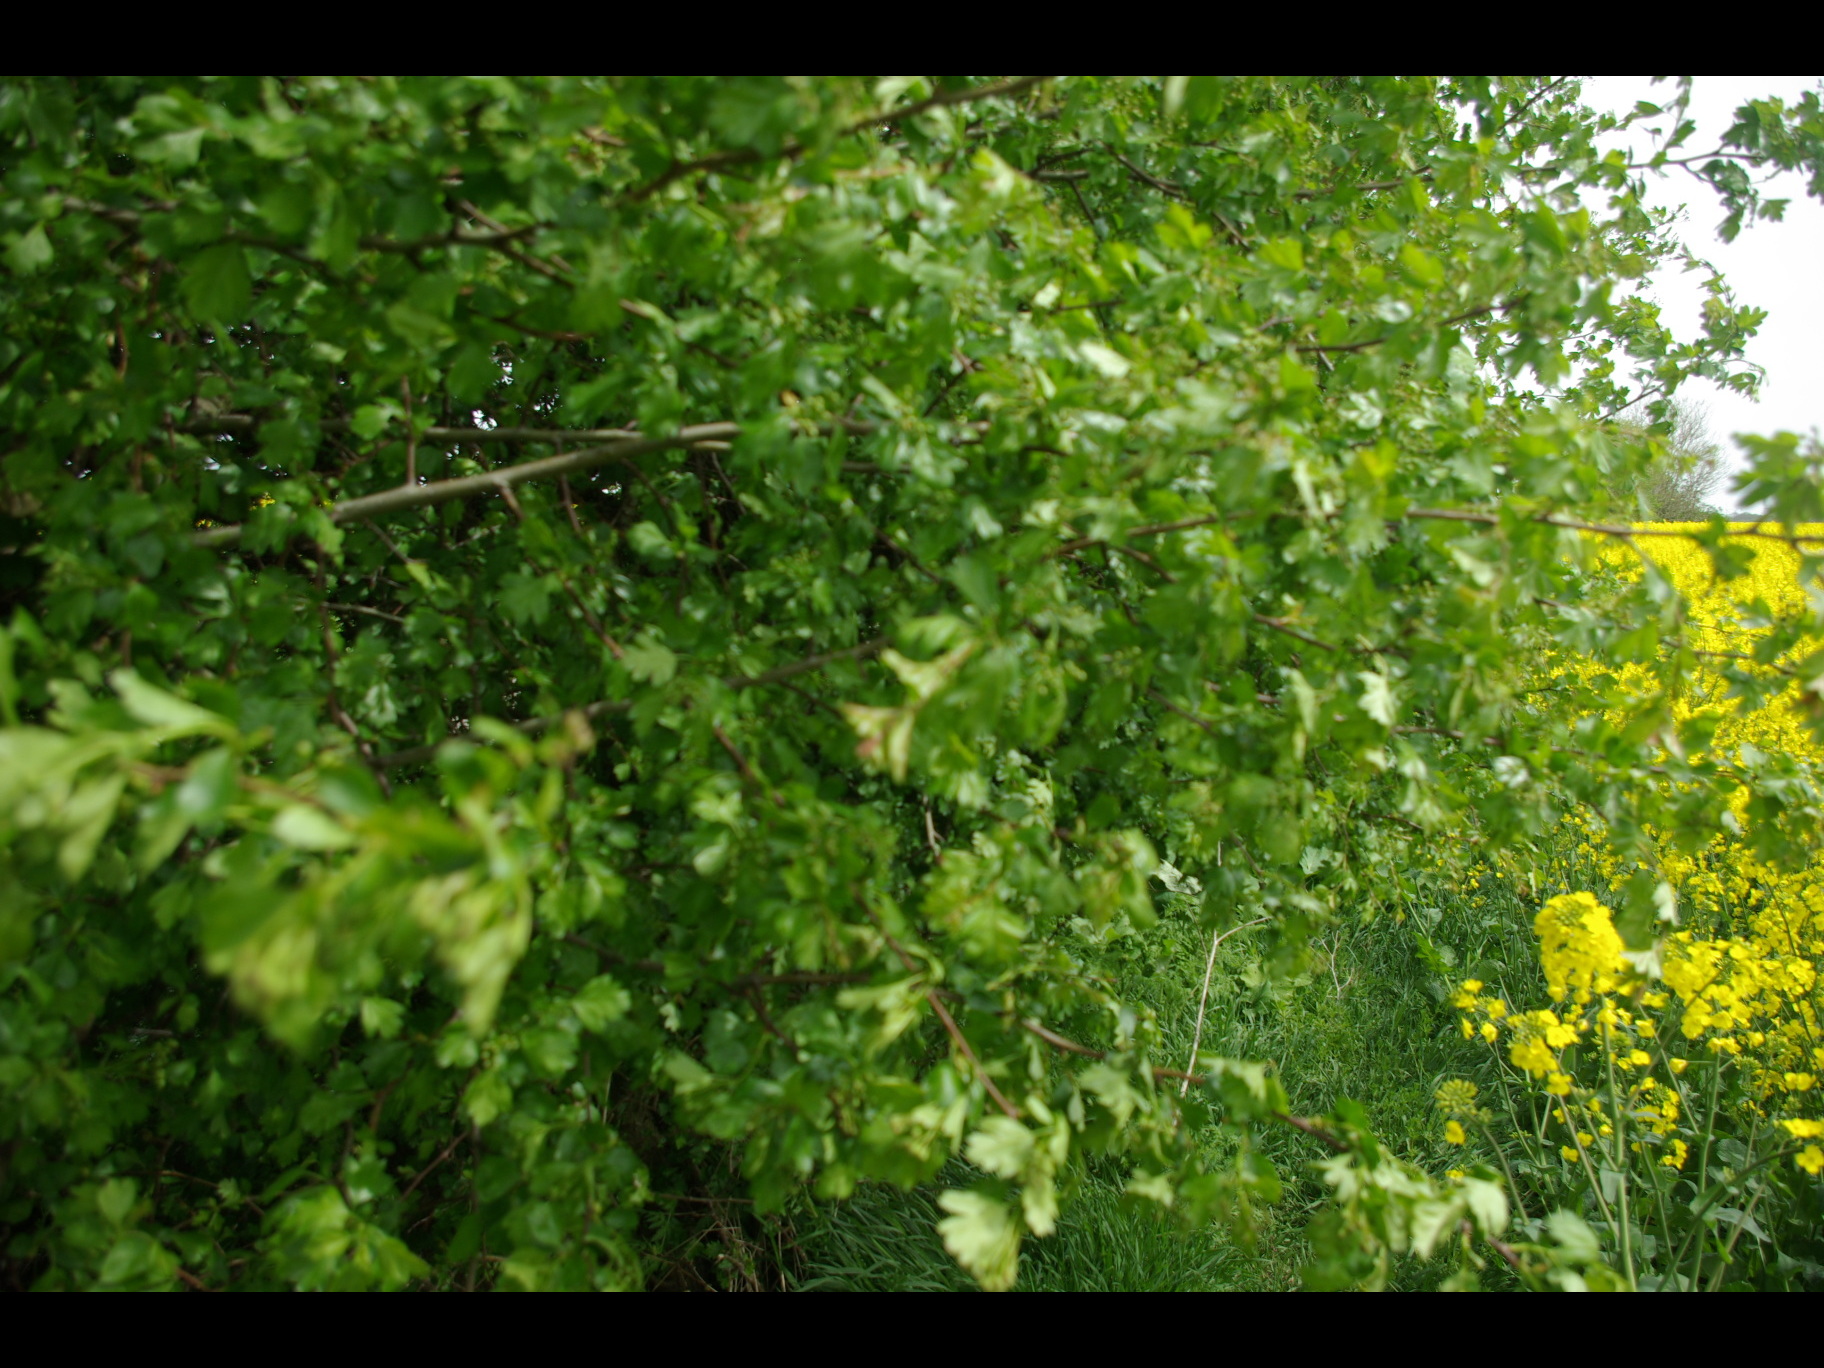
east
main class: Cropland
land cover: Rape and turnip rape
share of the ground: > 75 %
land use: Agriculture (excluding fallow land and kitchen gardens)
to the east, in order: Rape and turnip rape; Spontaneously vegetated surfaces; Paved roads, cycling and walking lanes; Grass margins; Rape and turnip rape; Common wheat
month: May
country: DE
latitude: 54.4928
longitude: 11.1572
